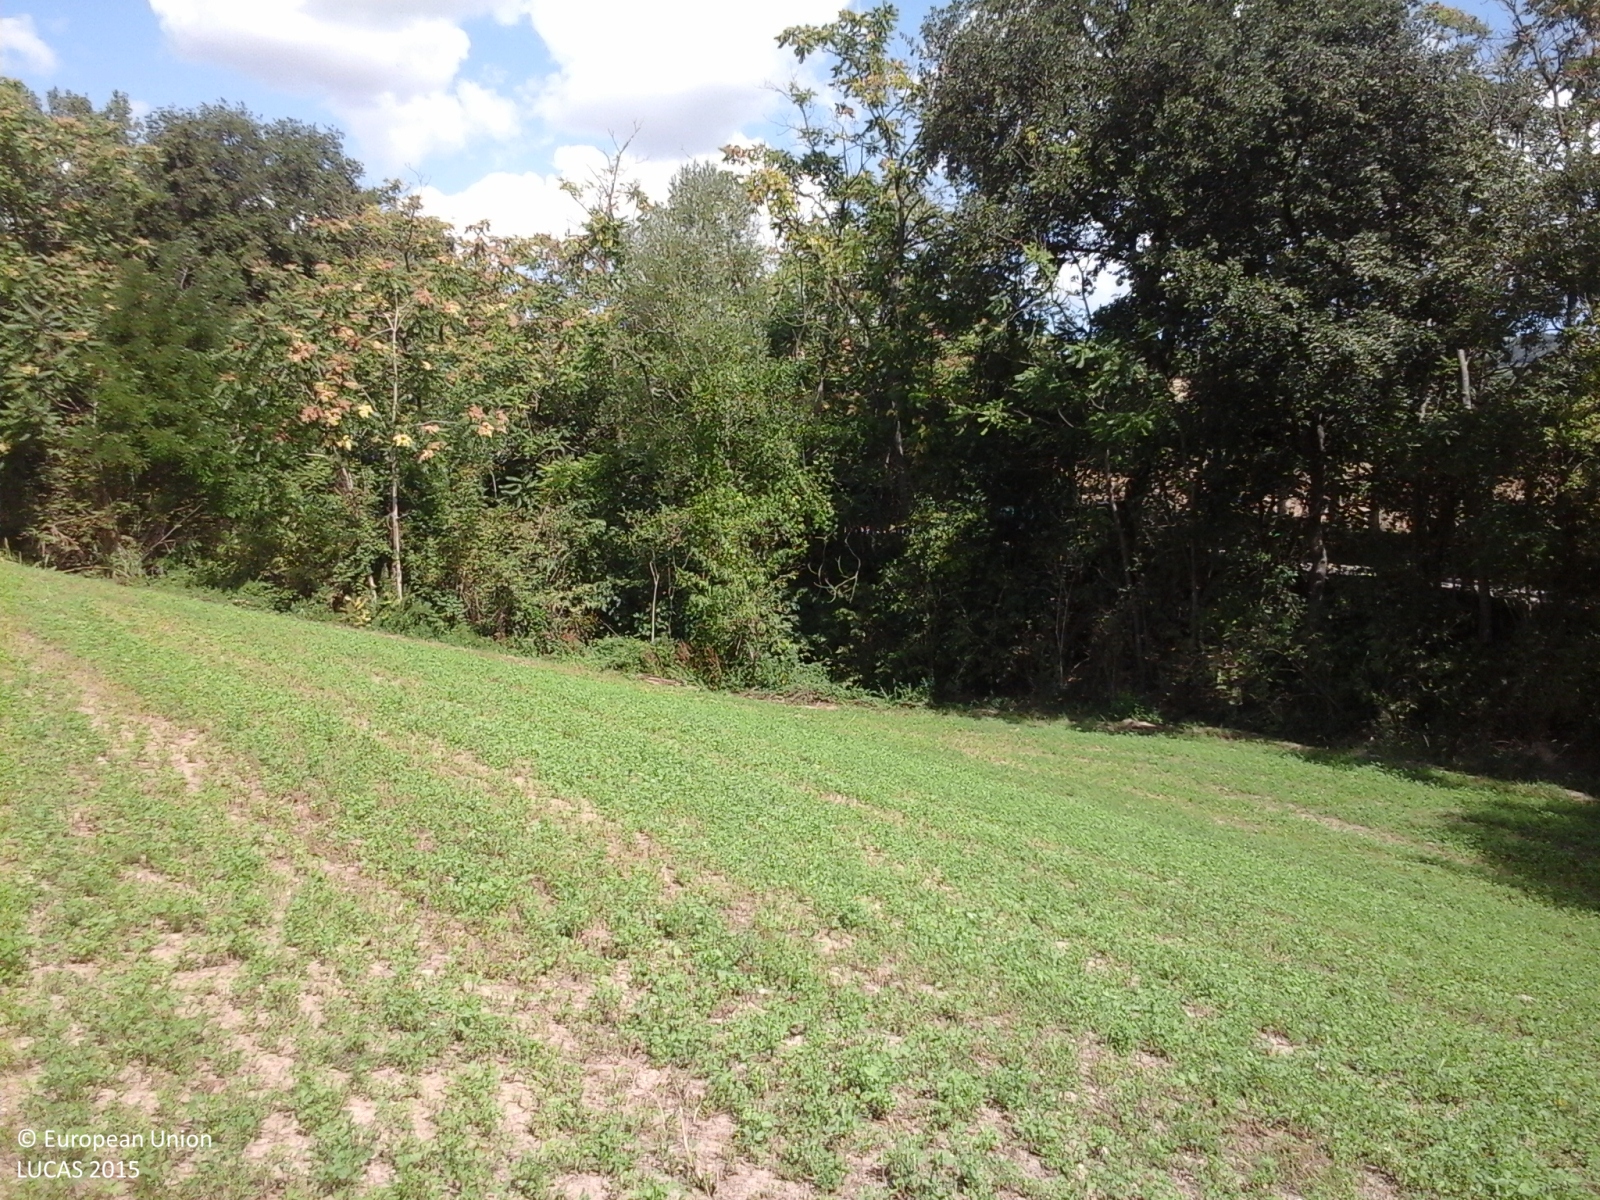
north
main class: Cropland
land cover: Lucerne
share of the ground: > 75 %
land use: Agriculture (excluding fallow land and kitchen gardens)
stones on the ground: < 10 %
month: September
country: IT
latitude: 42.6196
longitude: 13.7805
